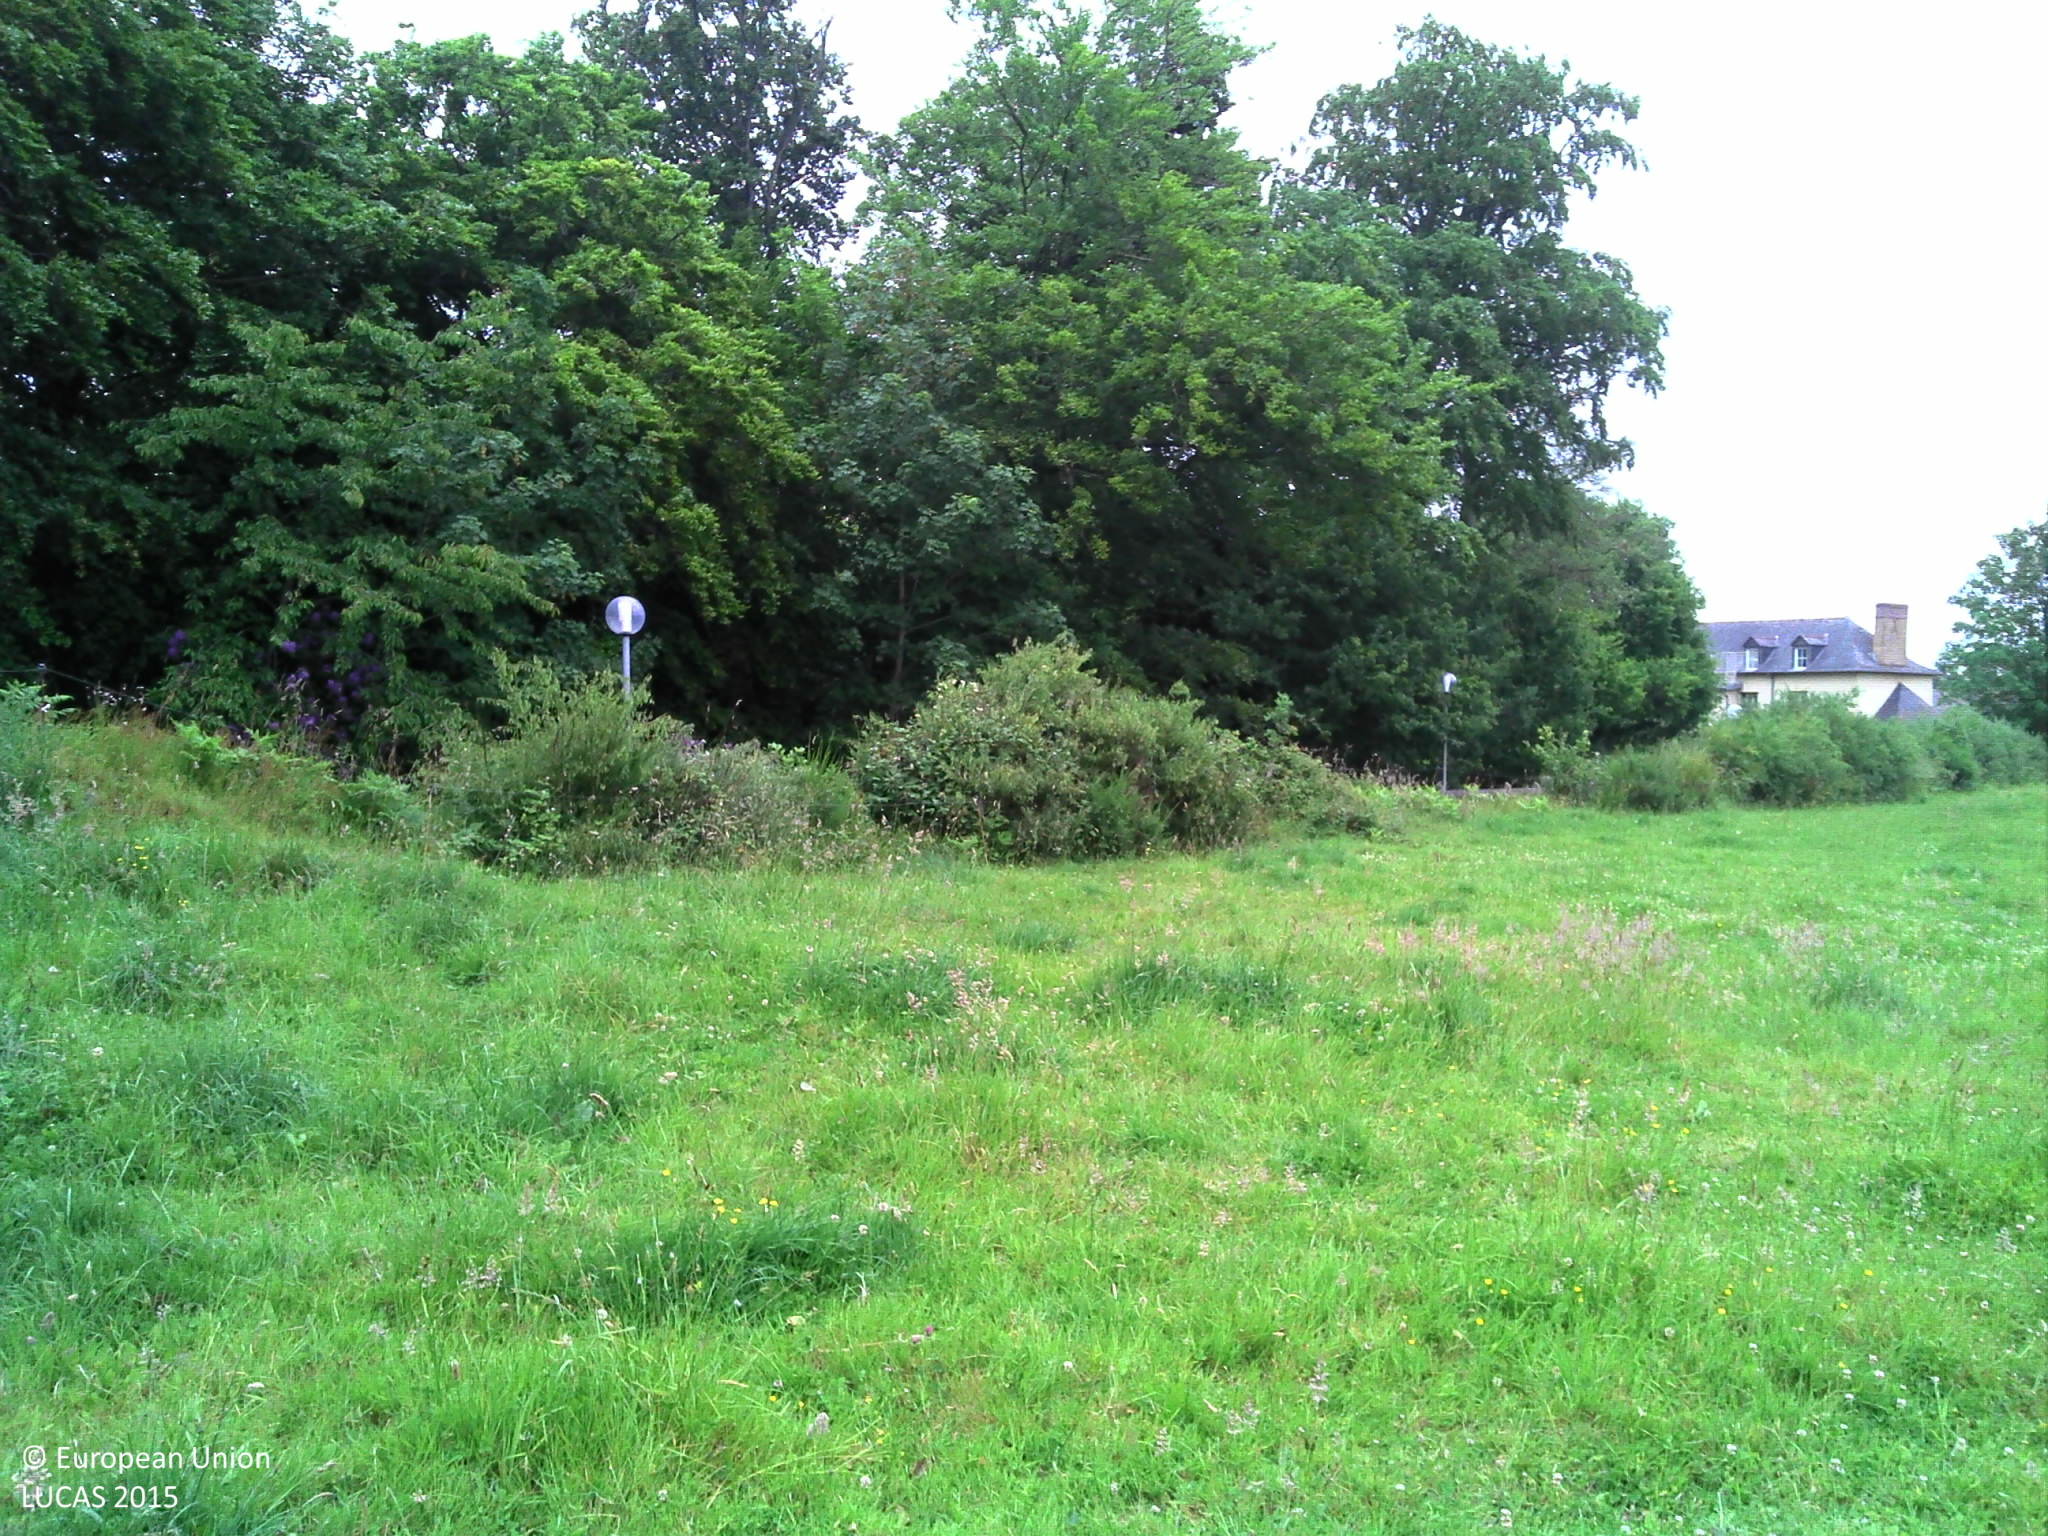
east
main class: Cropland
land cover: Apple fruit
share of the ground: 10 - 25 %
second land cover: Grassland without tree/shrub cover
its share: > 75 %
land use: Agriculture (excluding fallow land and kitchen gardens)
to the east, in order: Apple fruit; Grassland without tree/shrub cover; Managed hedges; Paved roads, cycling and walking lanes; Fences; Grass margins; Broadleaved woodland; Grassland without tree/shrub cover
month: June
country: FR
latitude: 48.1668
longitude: -1.6517
